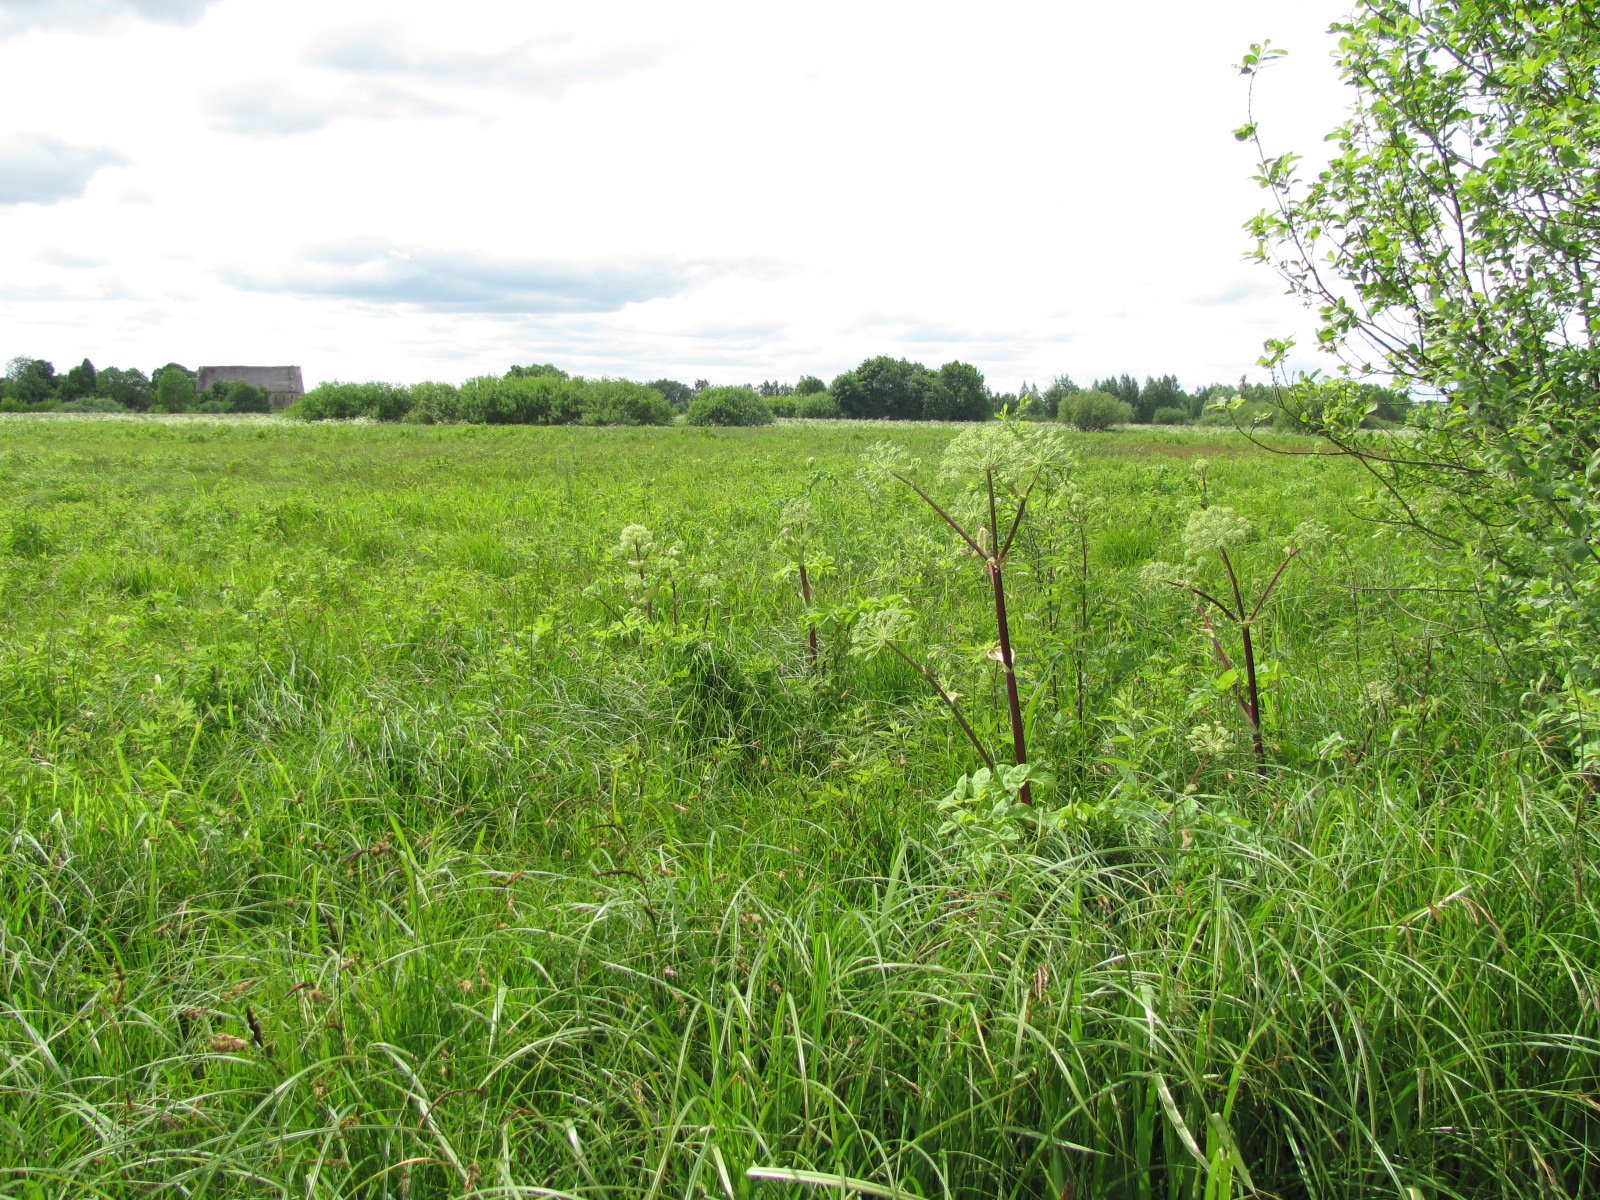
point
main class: Grassland
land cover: Grassland without tree/shrub cover
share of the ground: > 75 %
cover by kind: herbaceous plants 100 %
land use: Semi-natural and natural areas not in use
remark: Temporary flooded
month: June
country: LV
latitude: 56.6440
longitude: 23.7946
